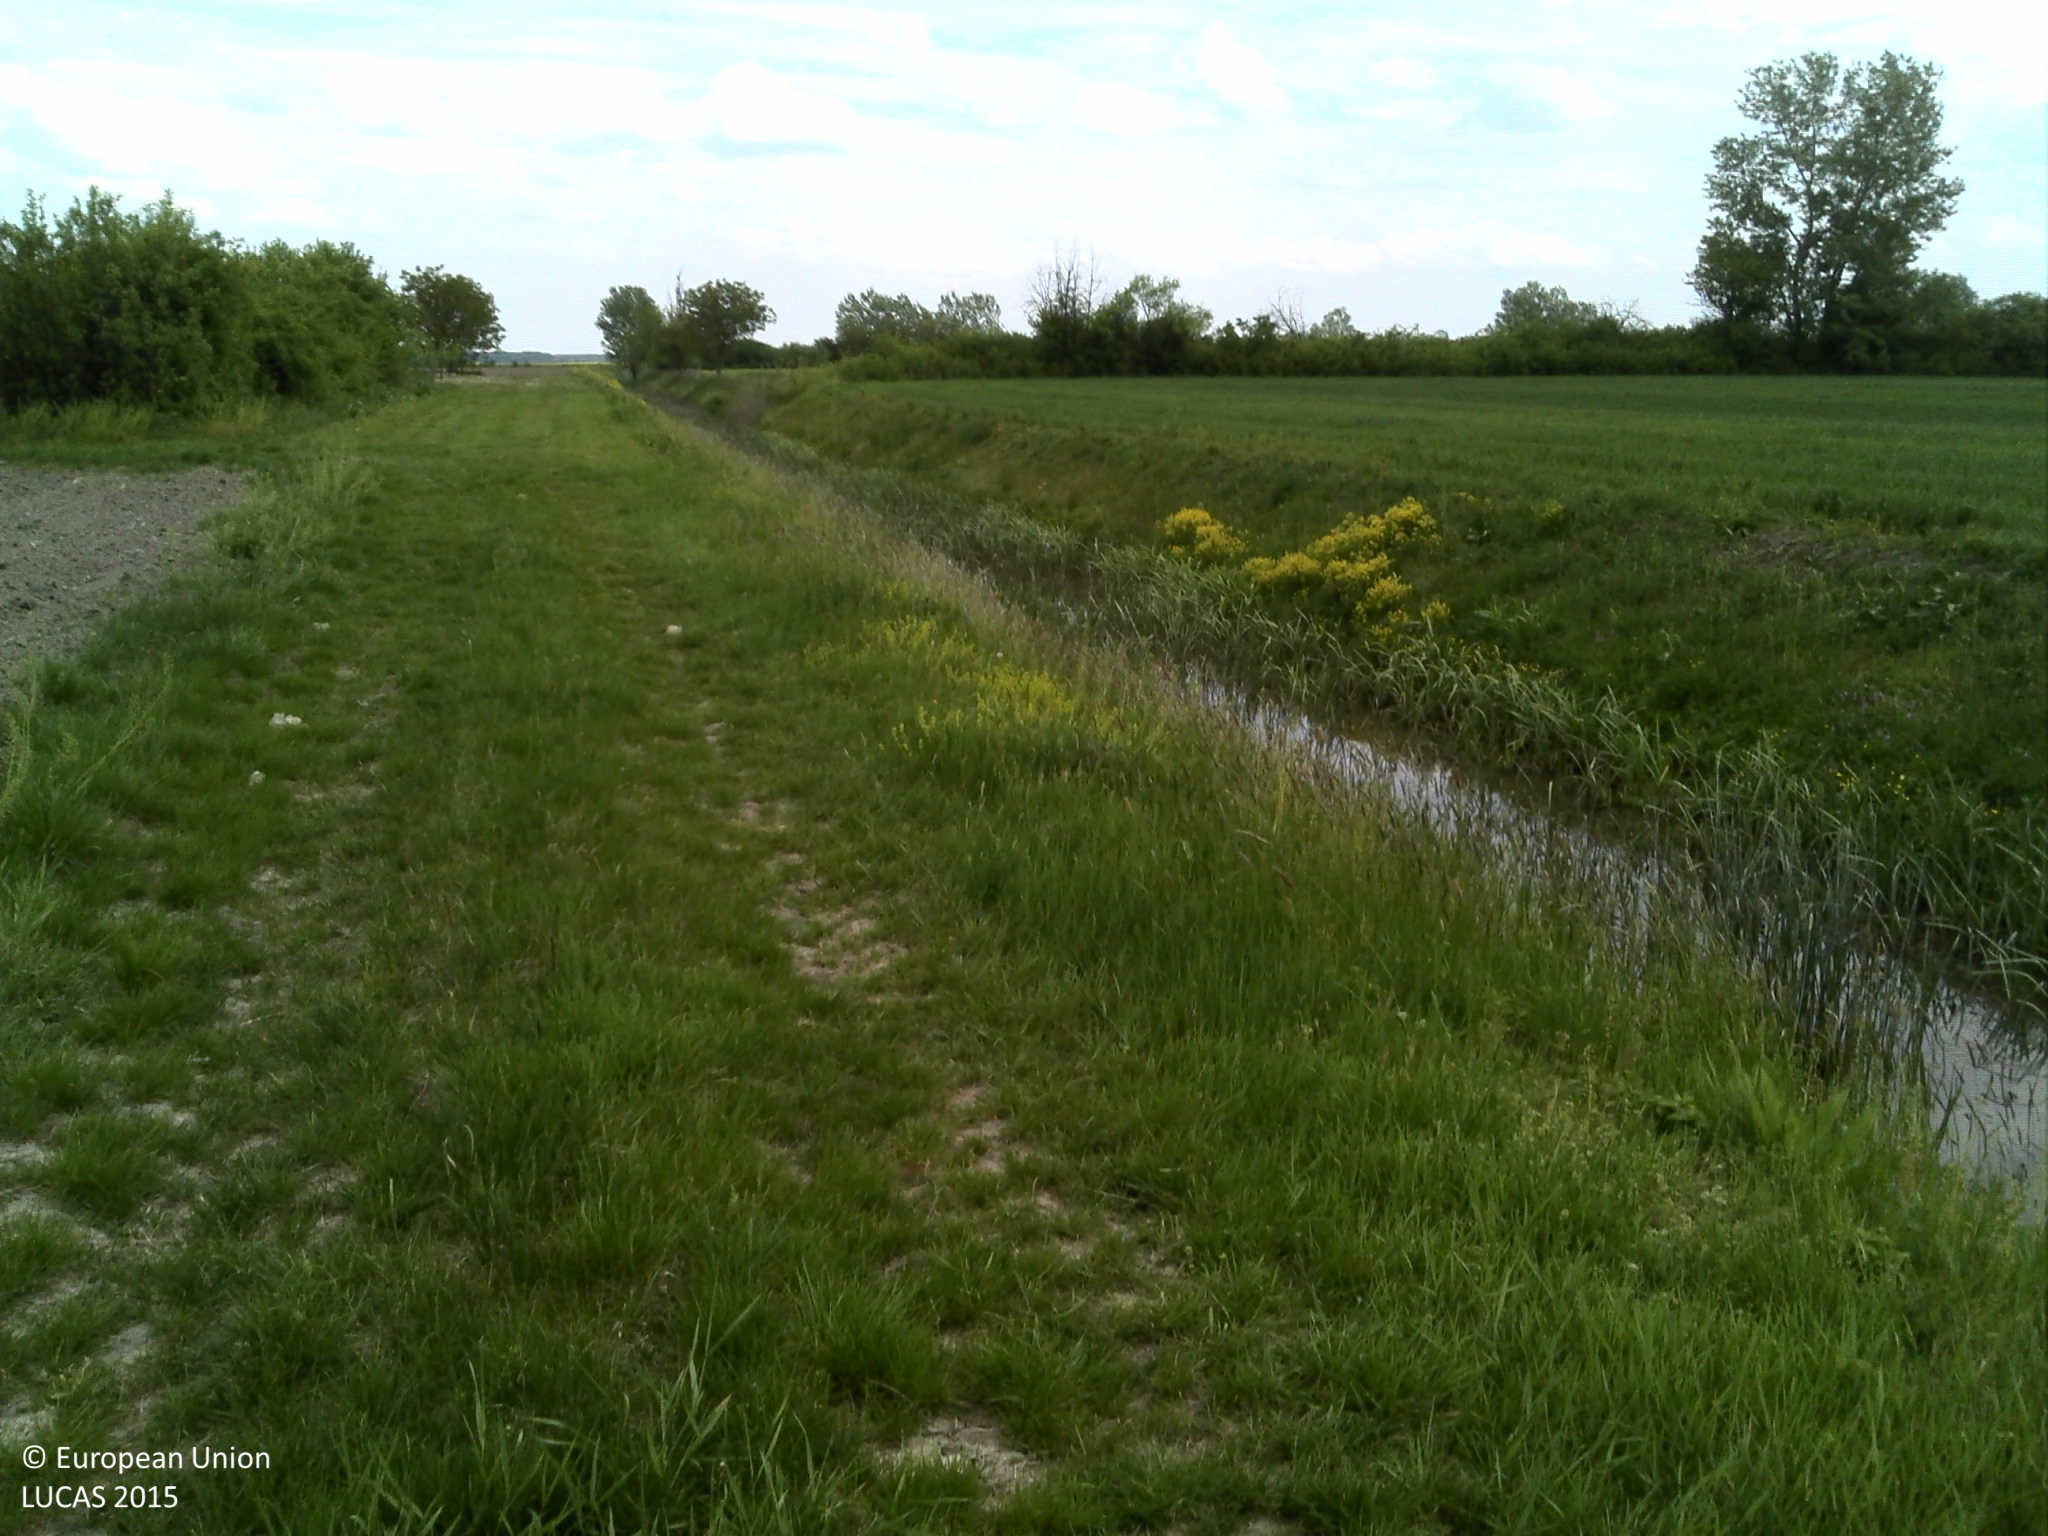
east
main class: Cropland
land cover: Soya
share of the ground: < 10 %
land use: Agriculture (excluding fallow land and kitchen gardens)
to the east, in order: Tracks; Grass margins; Ditches and canals; Grass margins; Other bare soil; Common wheat
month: April
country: HR
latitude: 44.9610
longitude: 18.9440
